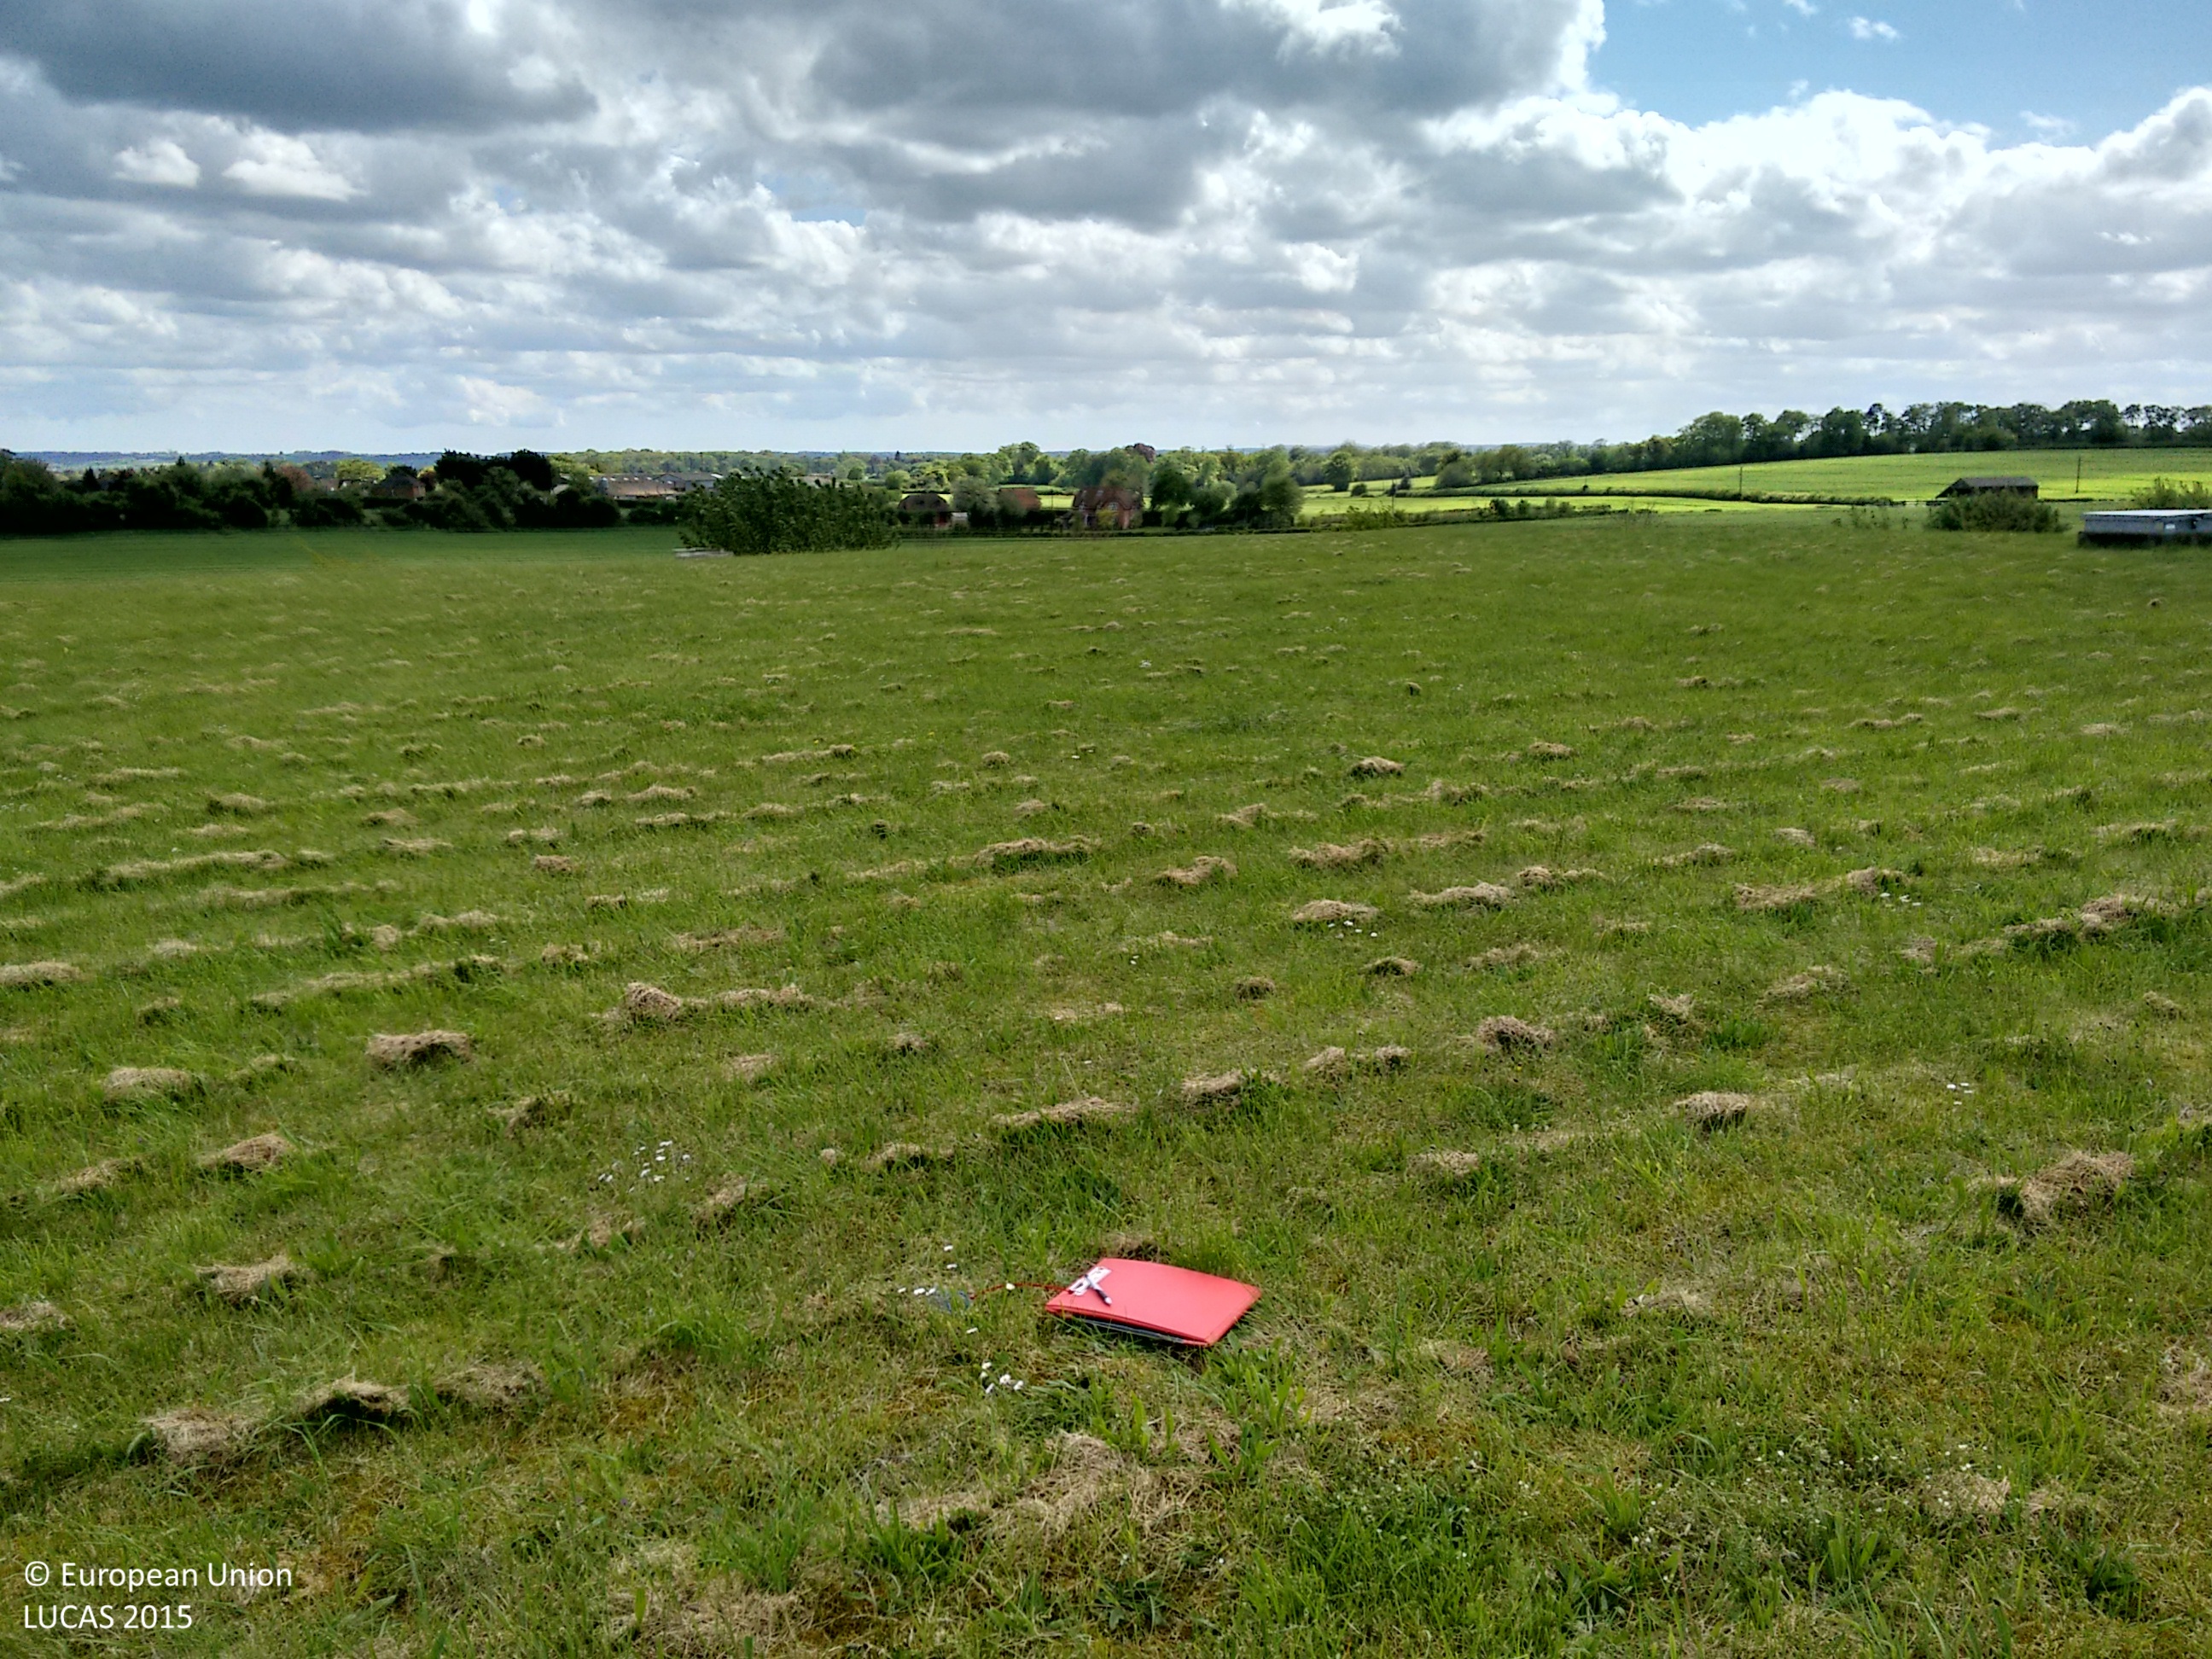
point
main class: Grassland
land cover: Grassland without tree/shrub cover
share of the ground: > 75 %
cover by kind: herbaceous plants 100 %
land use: Semi-natural and natural areas not in use
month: May
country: GB
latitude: 51.2867
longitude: -1.1589
